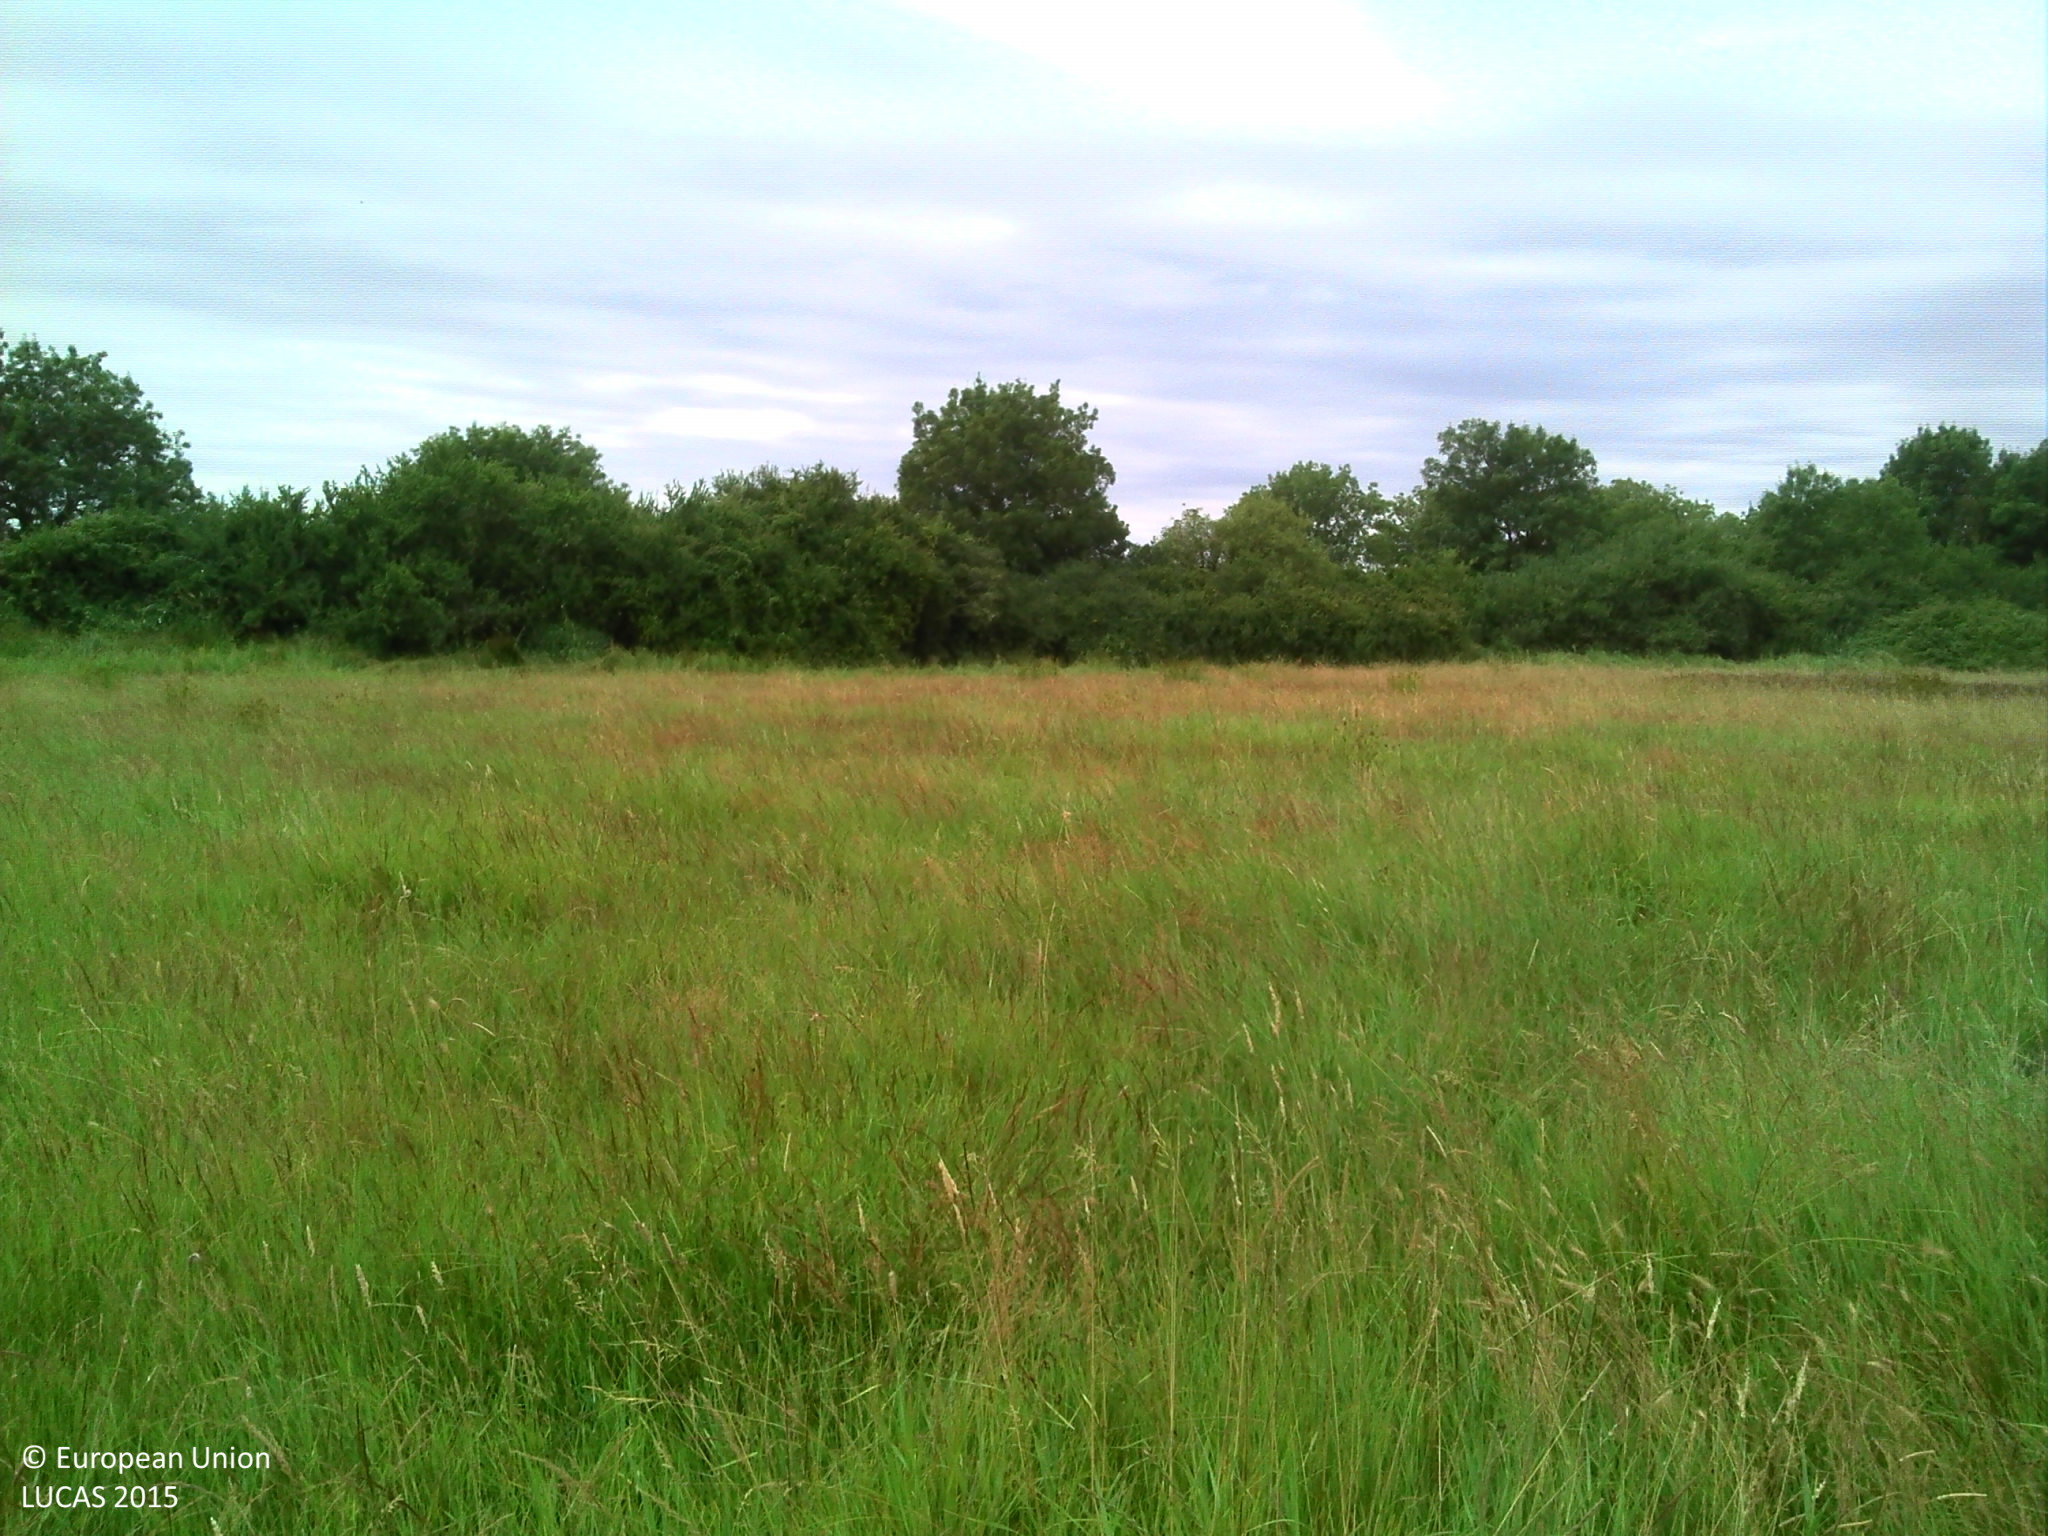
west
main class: Grassland
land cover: Grassland without tree/shrub cover
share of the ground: > 75 %
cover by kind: herbaceous plants 100 %
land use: Agriculture (excluding fallow land and kitchen gardens)
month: July
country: FR
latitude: 47.2343
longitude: -1.8683
